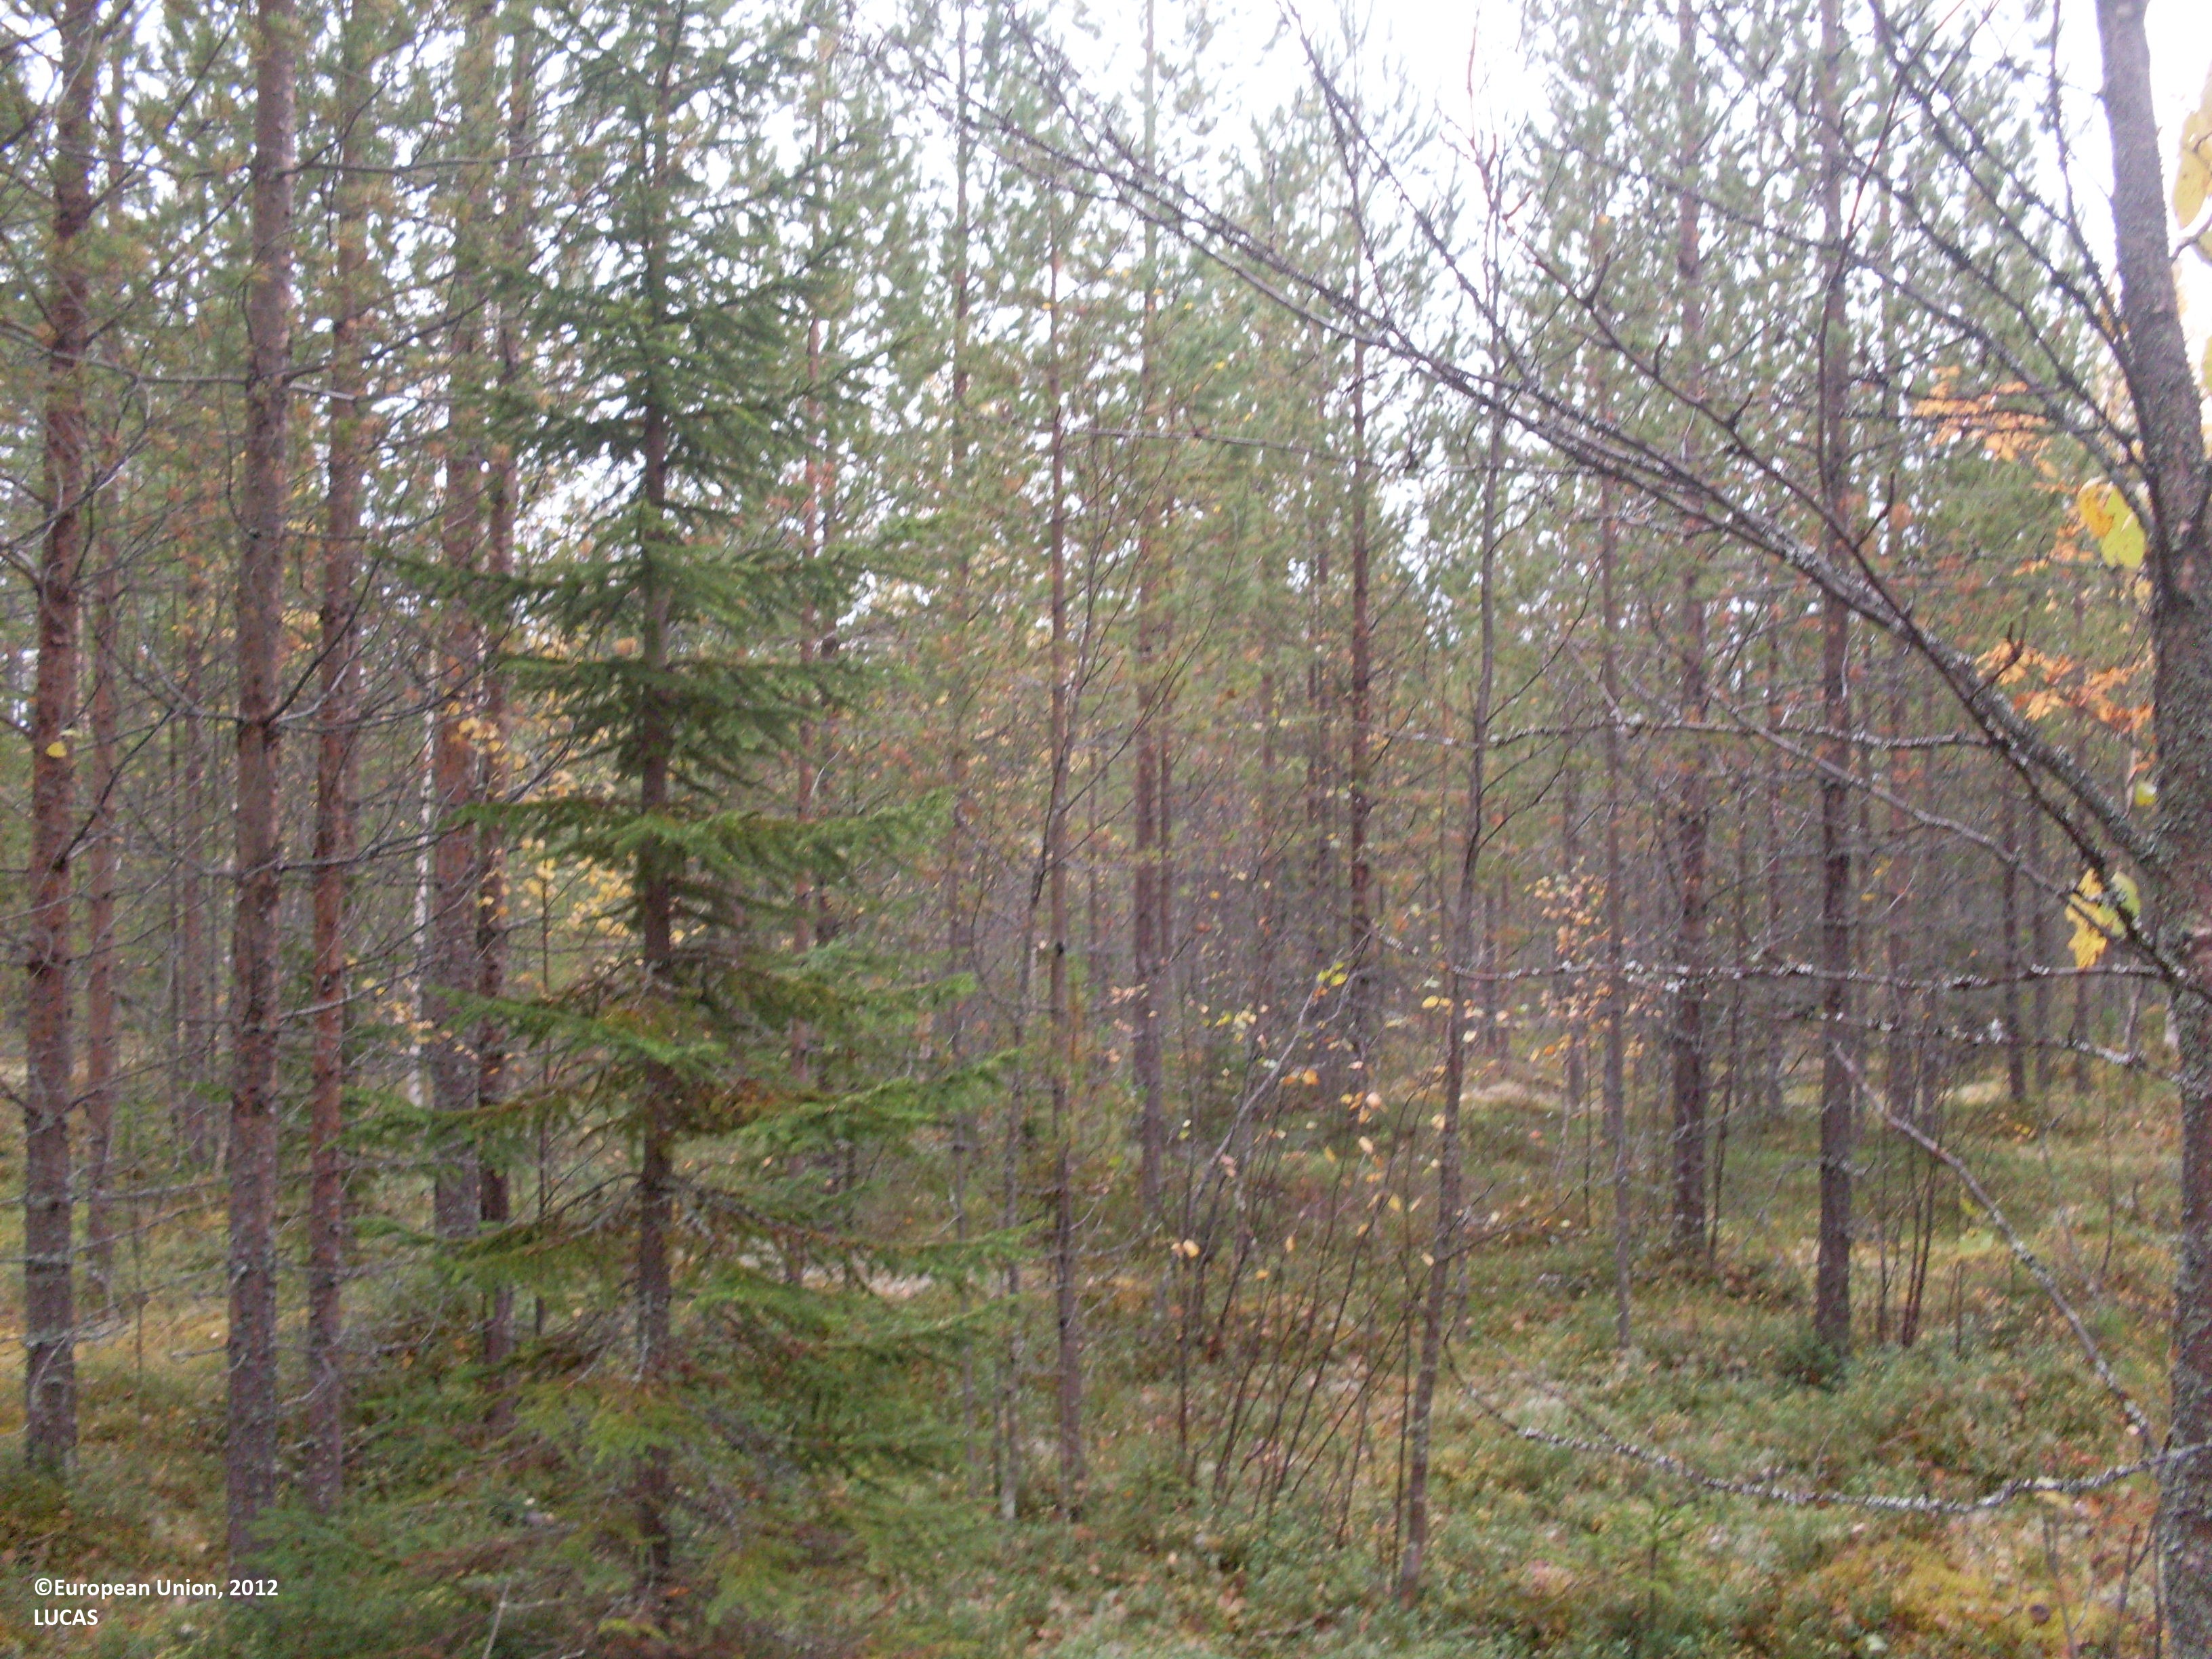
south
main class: Woodland
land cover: Pine dominated mixed woodland
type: boreal forest
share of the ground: 50 - 75 %
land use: Forestry
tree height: > 5 m
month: September
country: FI
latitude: 64.6402
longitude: 28.9611
